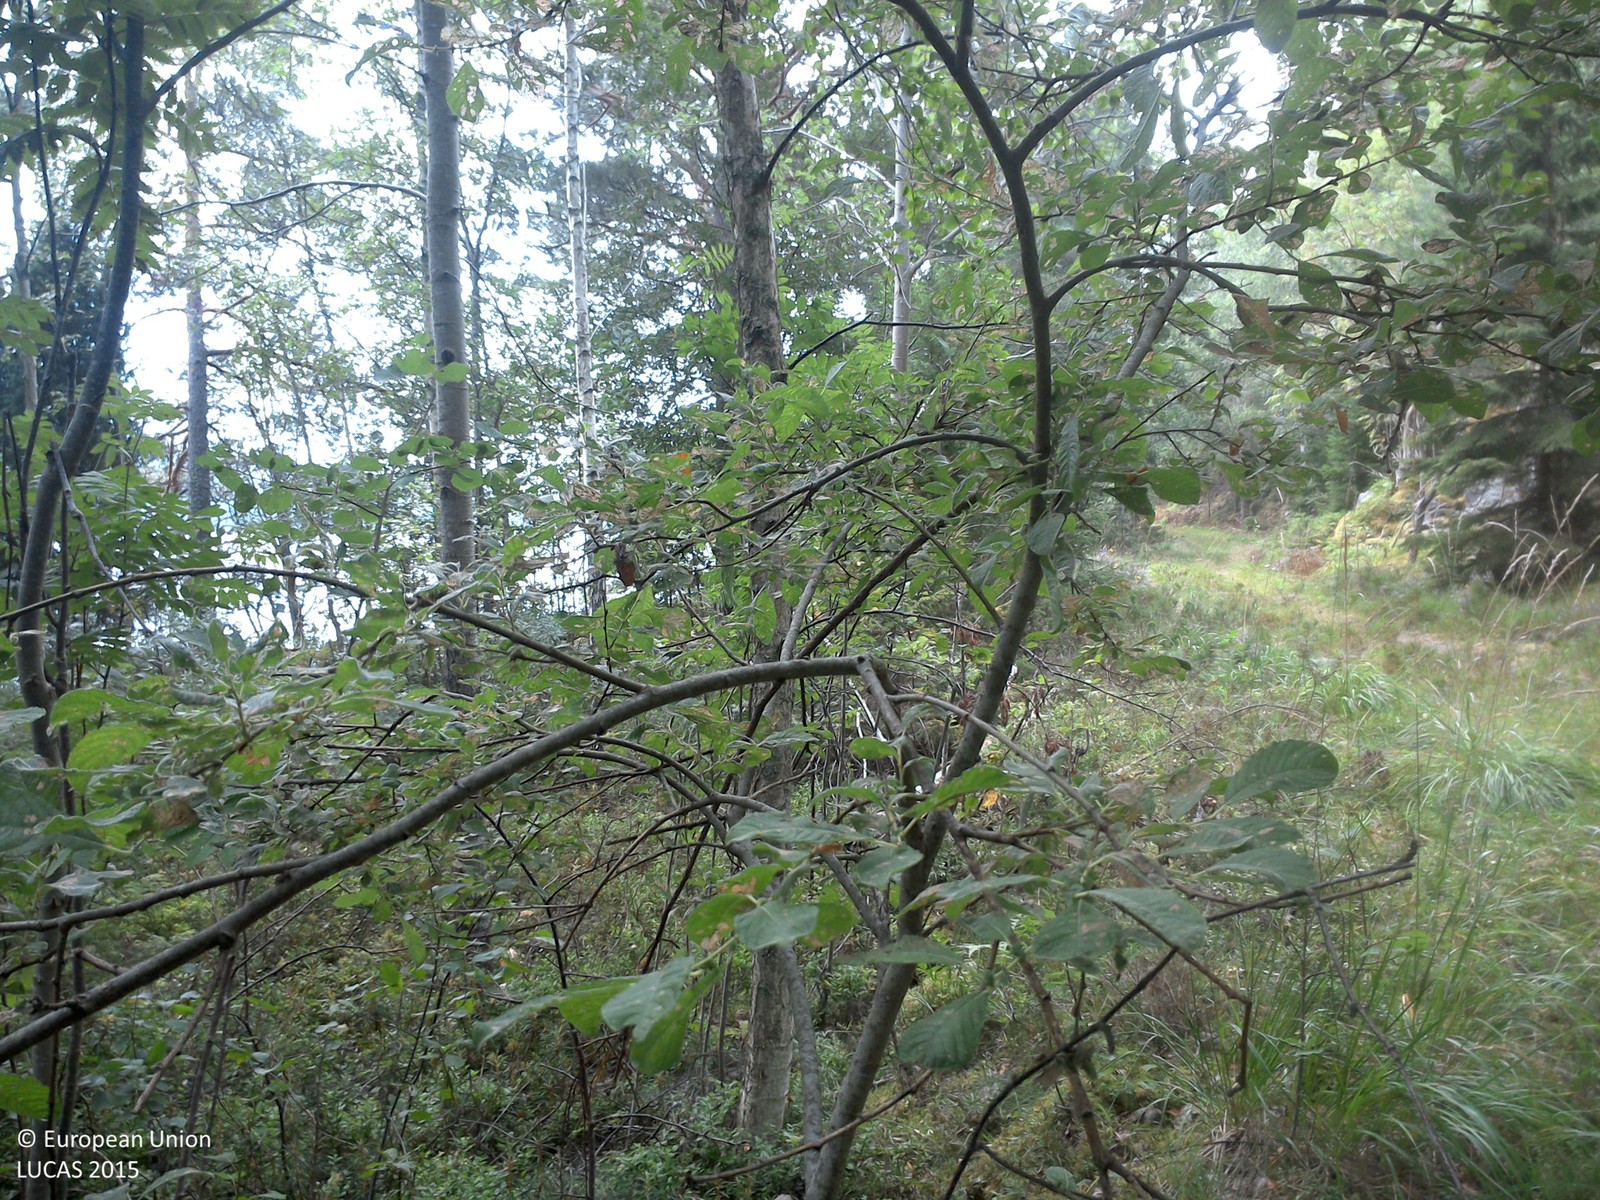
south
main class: Woodland
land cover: Broadleaved woodland
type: boreal forest
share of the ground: 50 - 75 %
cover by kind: broadleaved forest trees 50 %, lichens and mosses 35 %, herbaceous plants 15 %
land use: Forestry
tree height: > 5 m
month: August
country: SE
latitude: 58.0417
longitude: 15.3310
